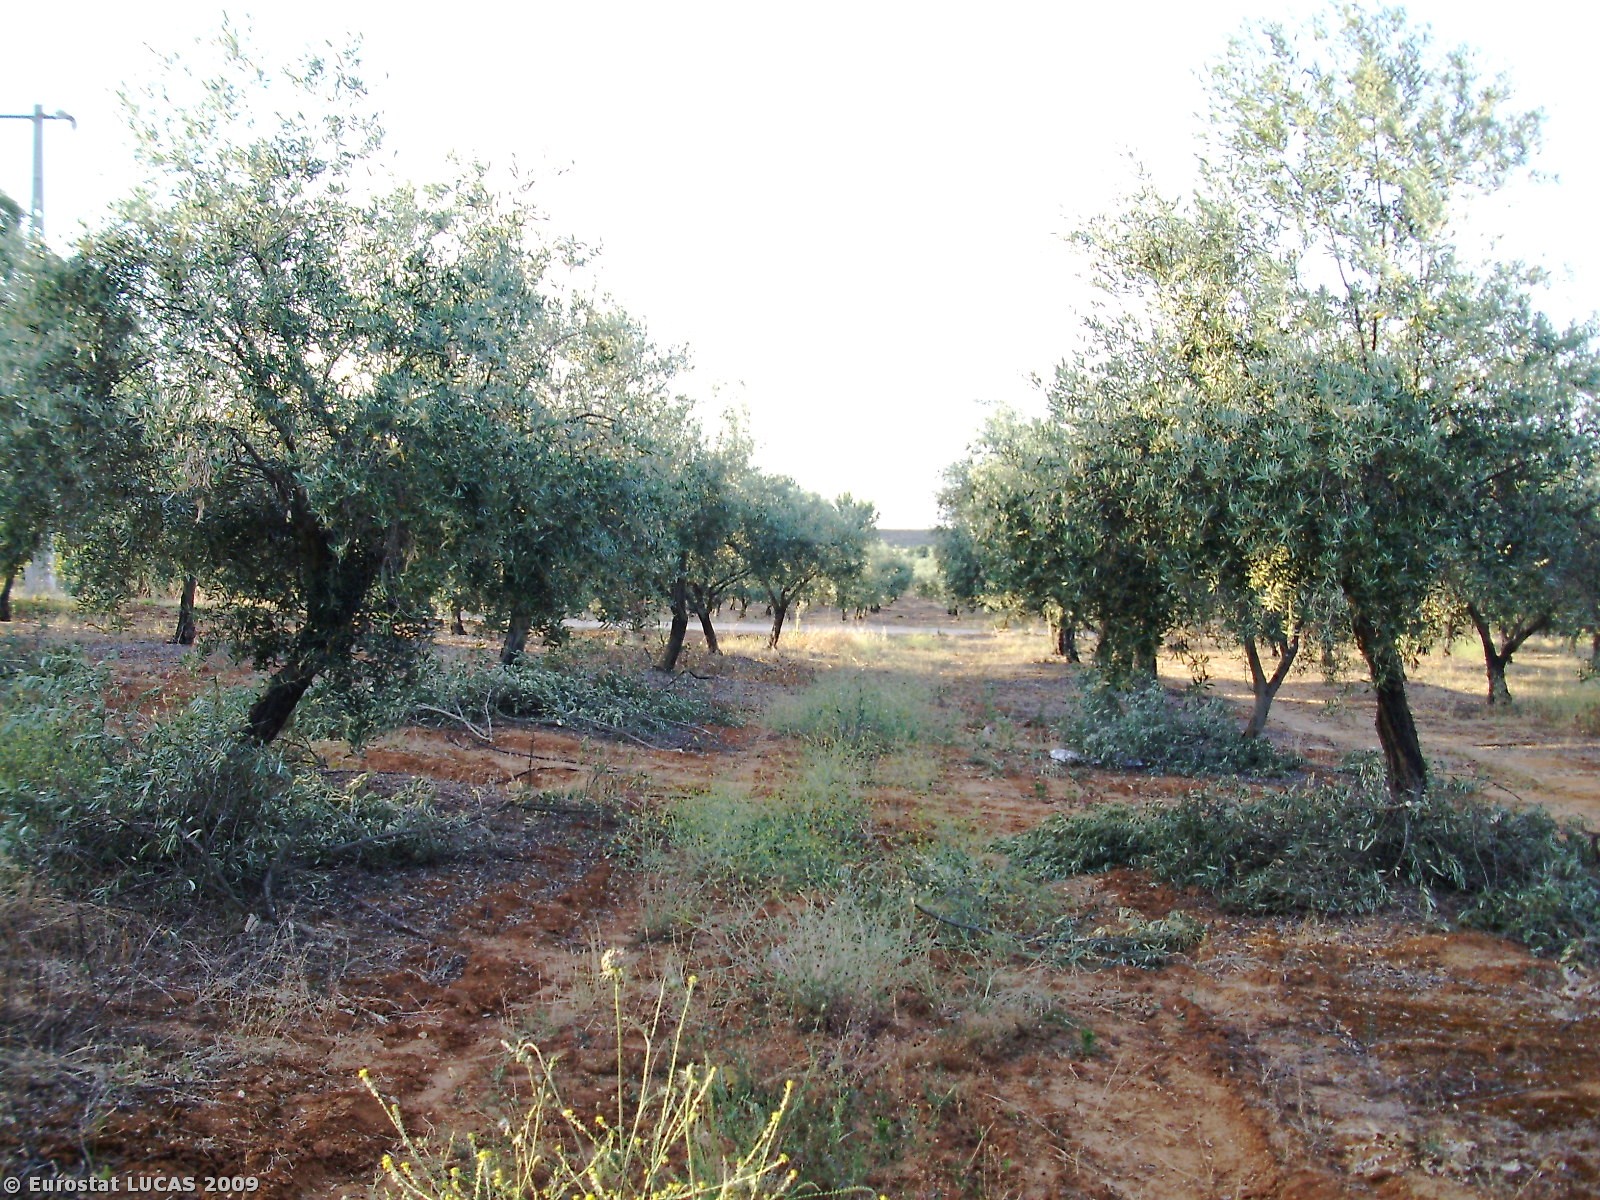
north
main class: Cropland
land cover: Olive groves
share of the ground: > 75 %
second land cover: Bare land
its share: 10 - 25 %
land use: Agriculture (excluding fallow land and kitchen gardens)
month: May
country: PT
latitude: 38.9234
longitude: -7.1806
